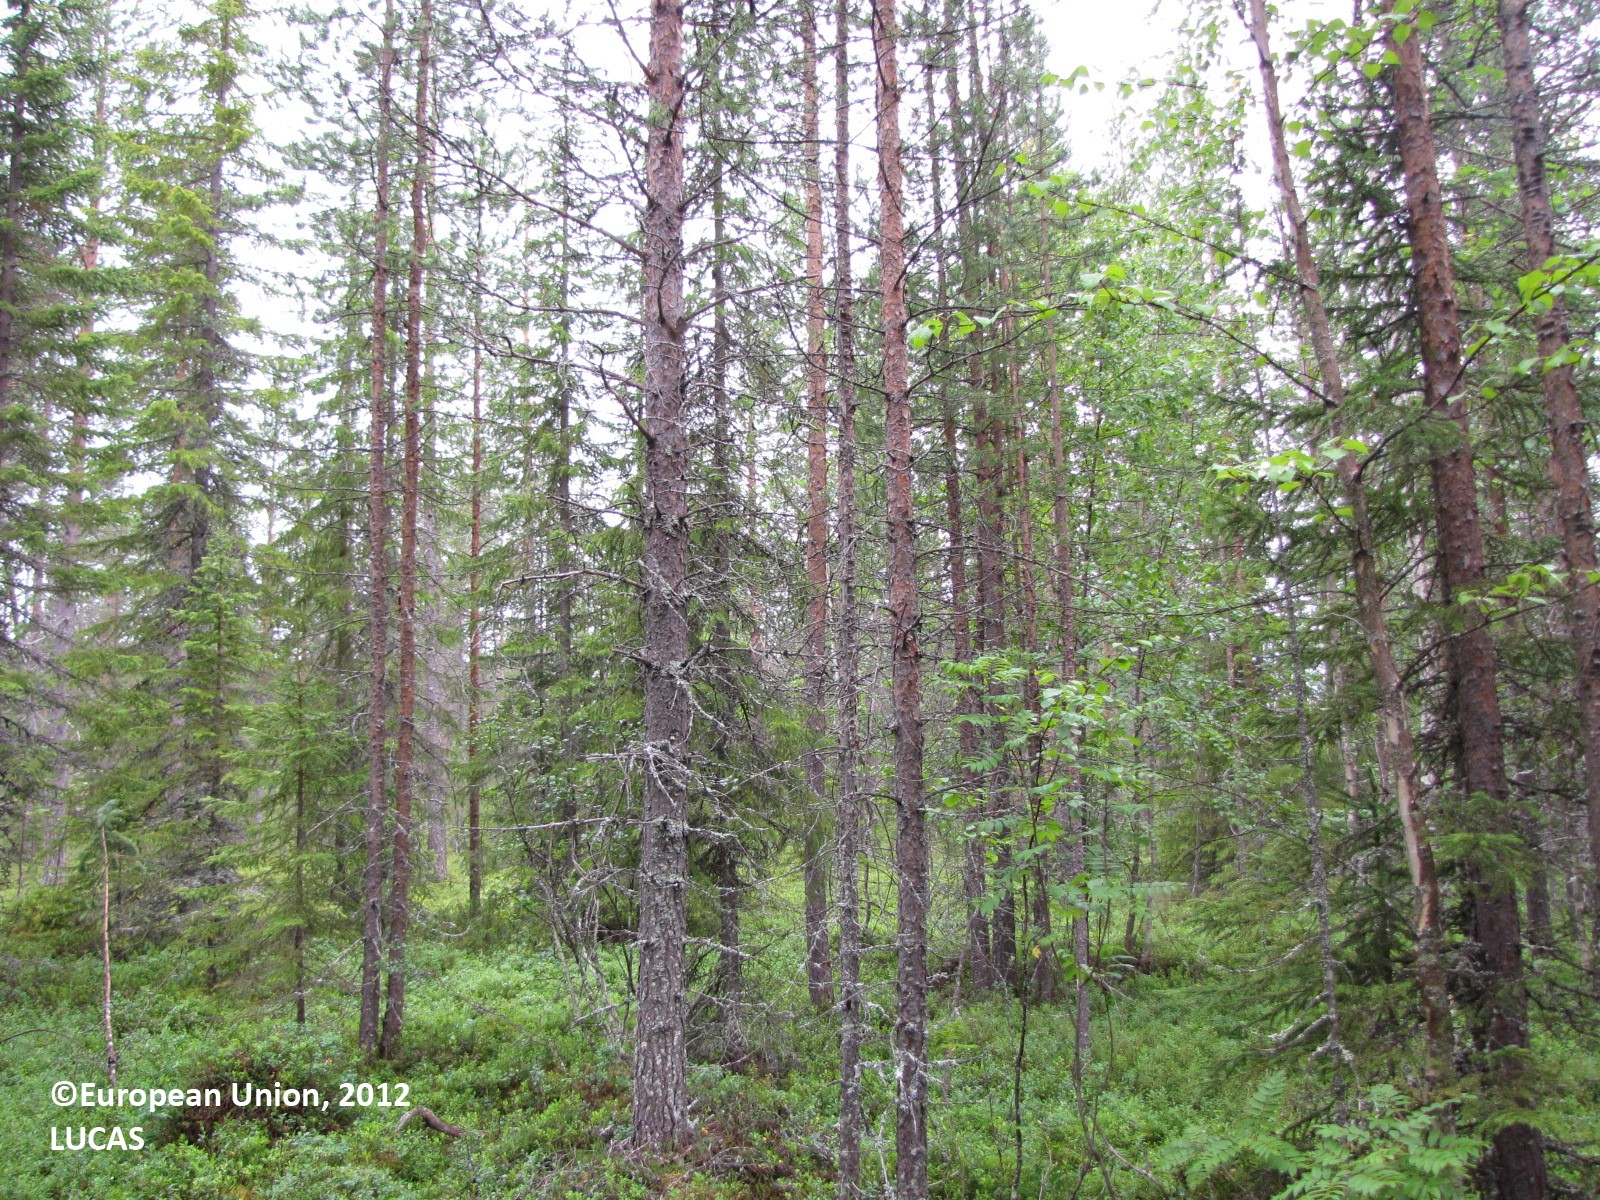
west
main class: Woodland
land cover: Other coniferous woodland
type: boreal forest
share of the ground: 50 - 75 %
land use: Forestry
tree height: > 5 m
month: July
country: FI
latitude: 66.6281
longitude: 24.8916
